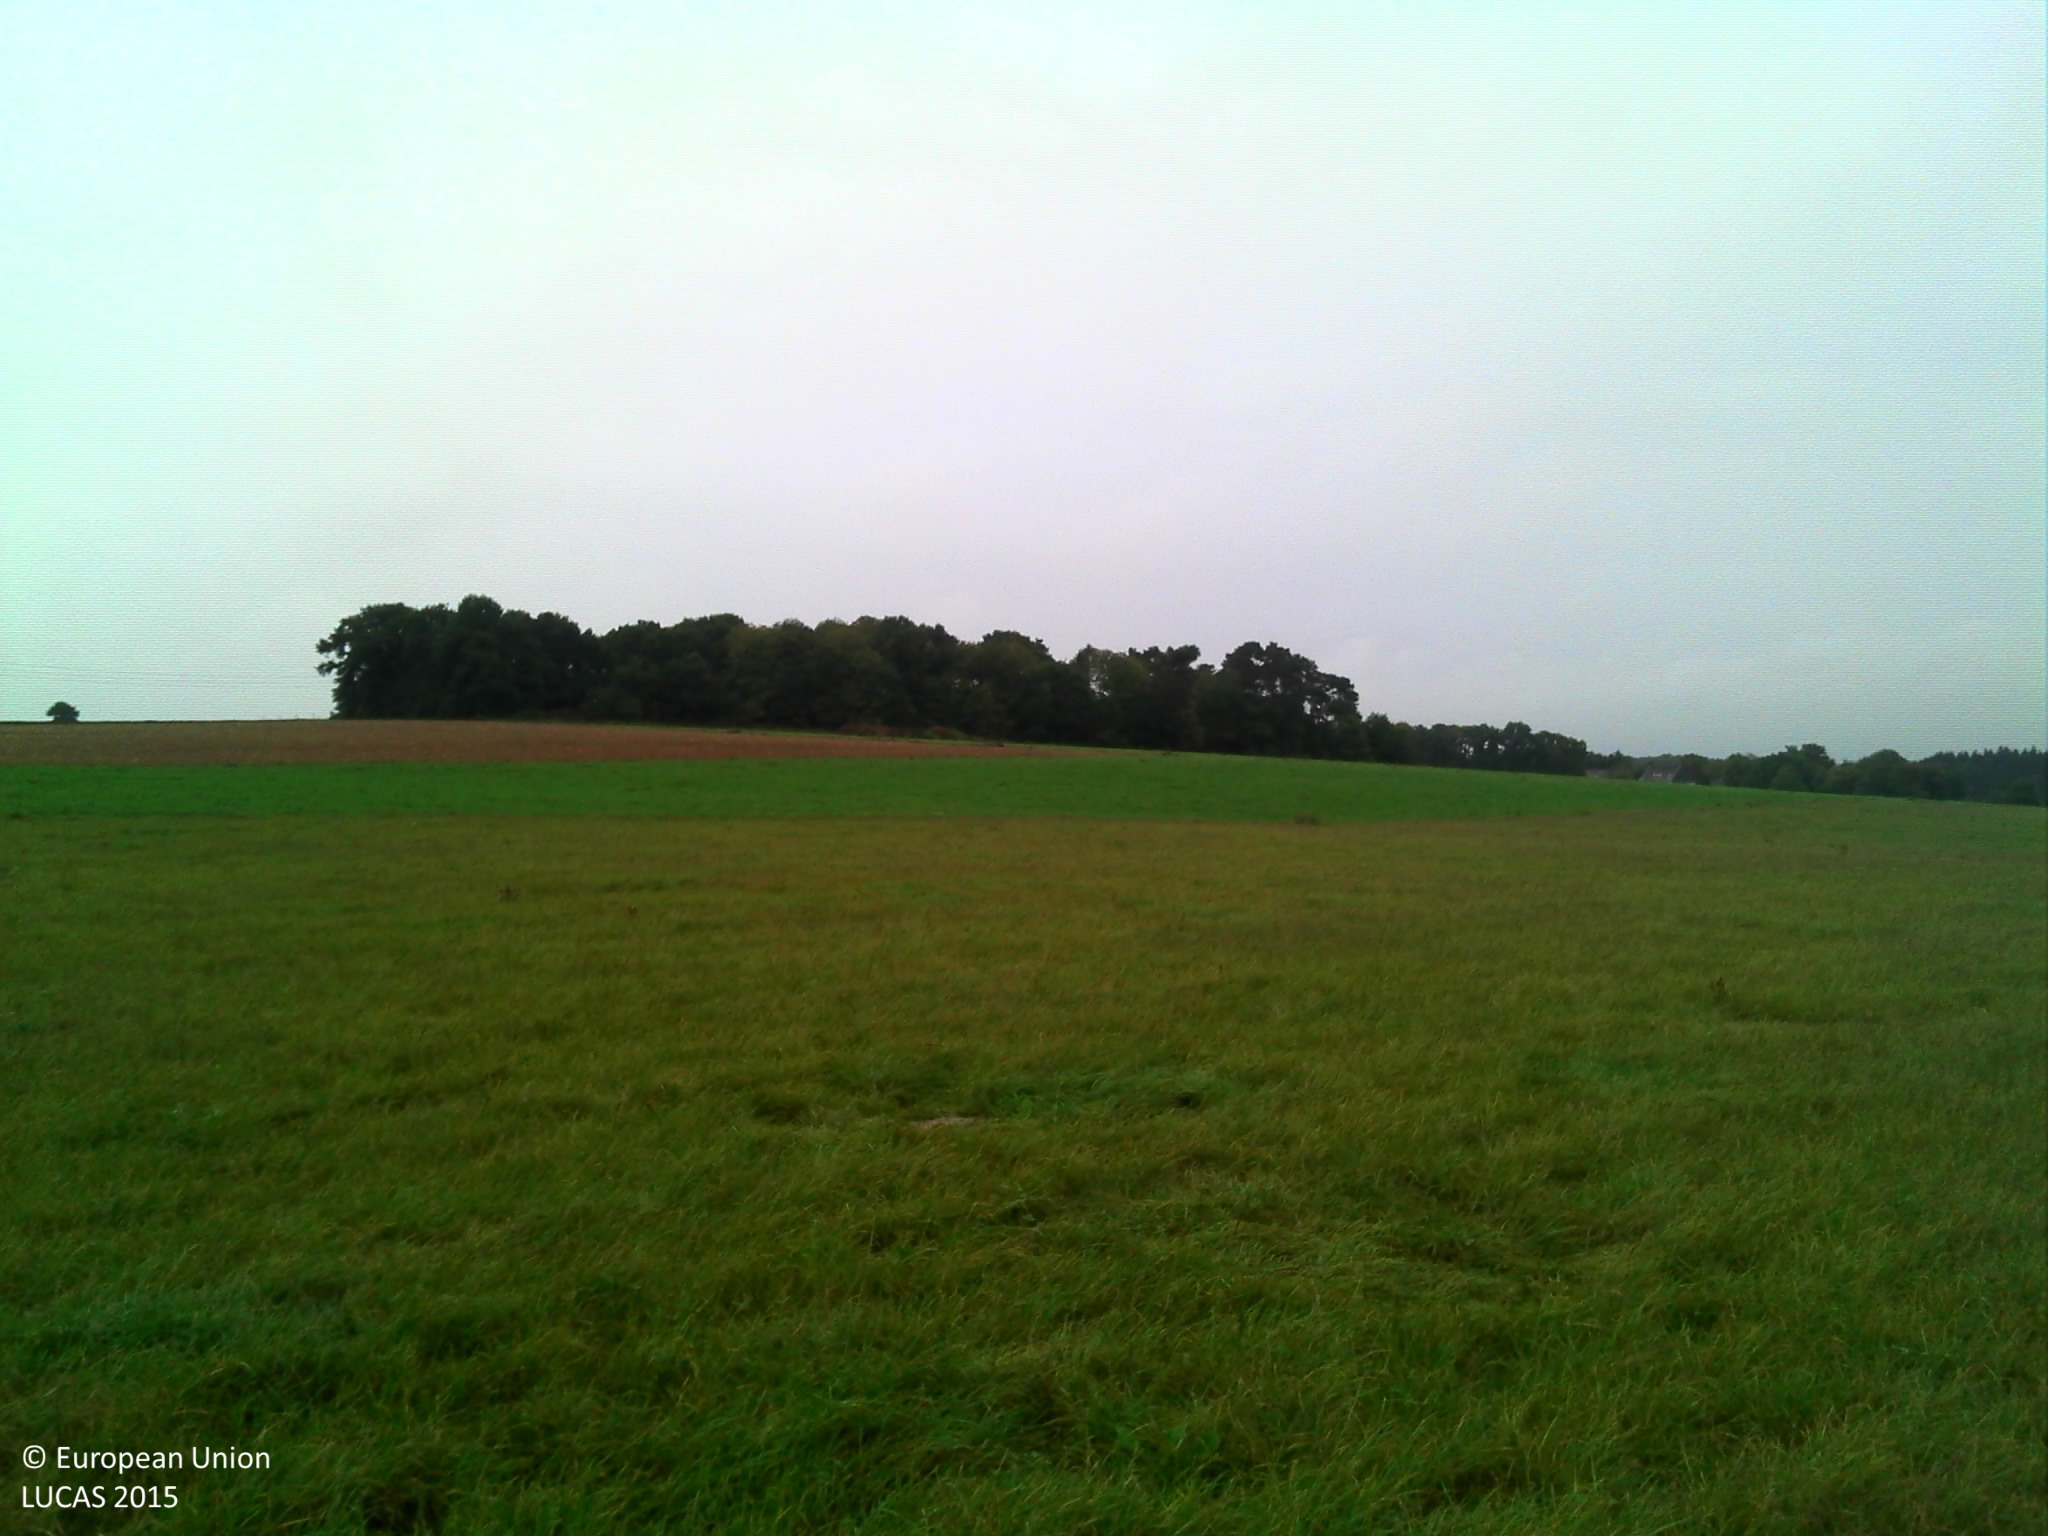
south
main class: Cropland
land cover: Temporary grasslands
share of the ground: > 75 %
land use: Agriculture (excluding fallow land and kitchen gardens)
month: October
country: FR
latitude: 47.9788
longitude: -2.3694
